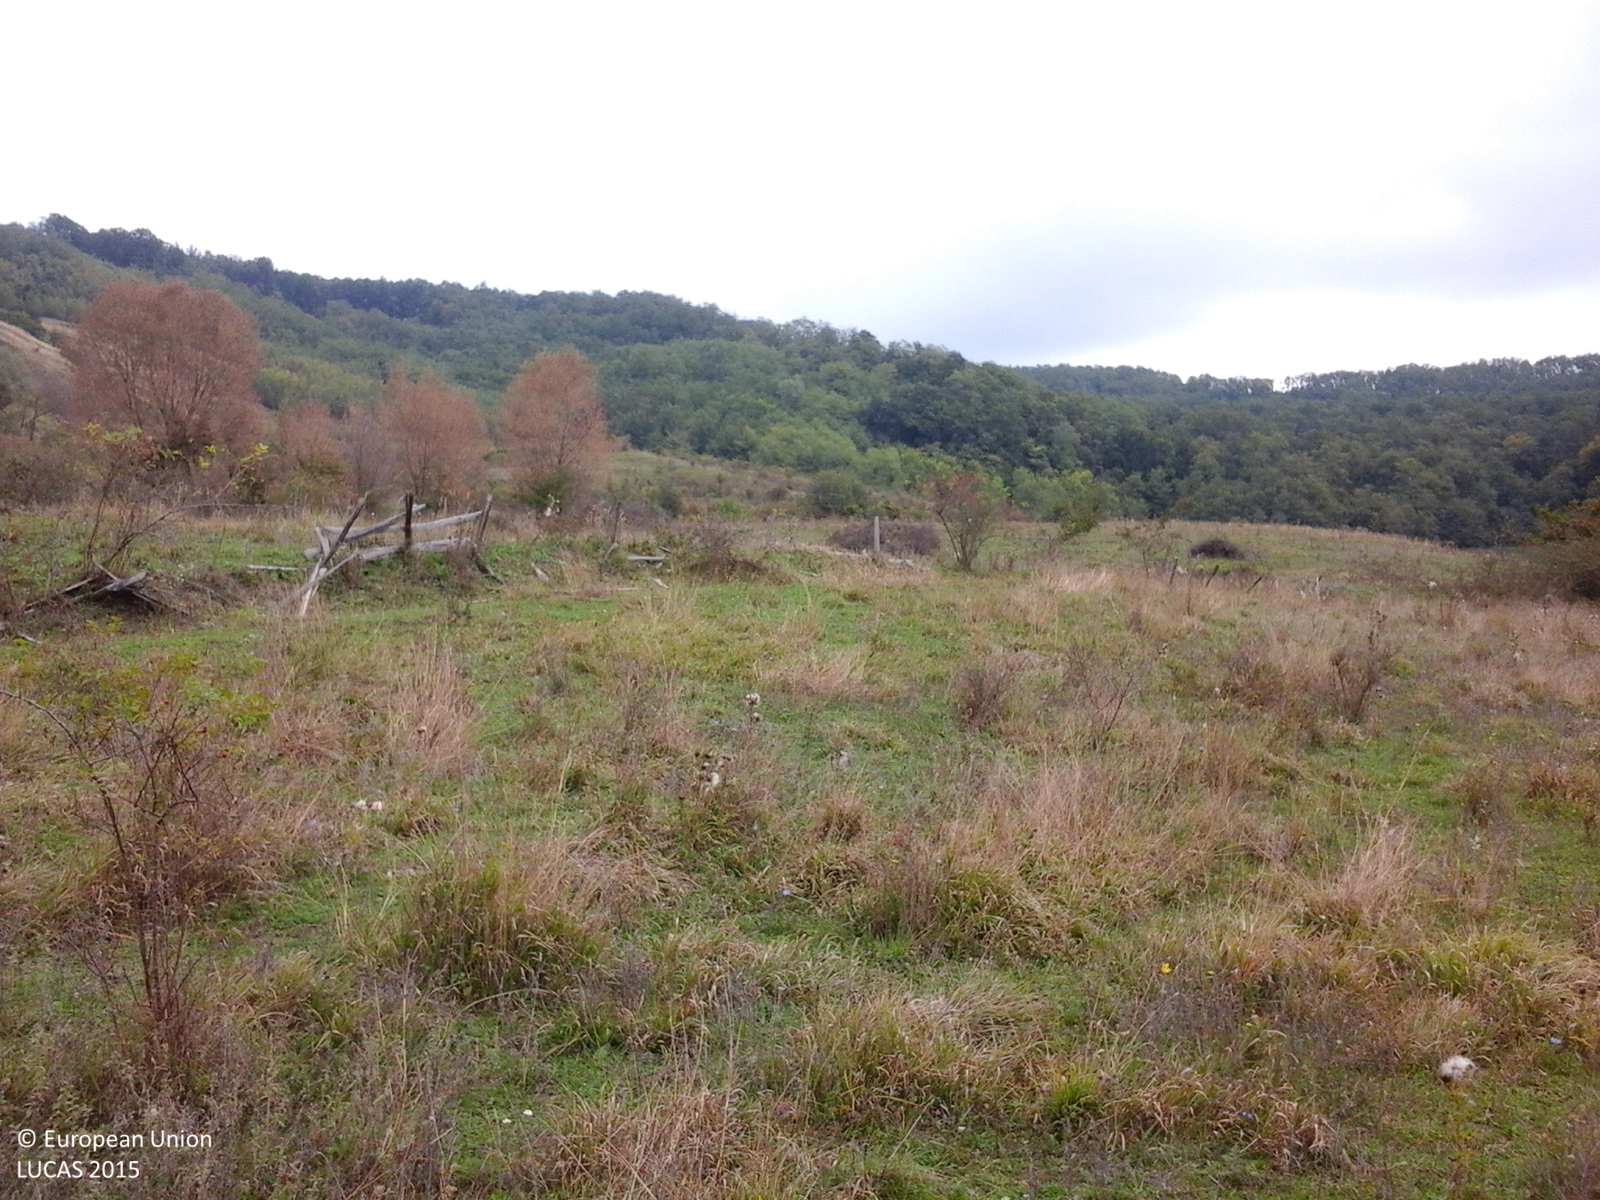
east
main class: Grassland
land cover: Spontaneously vegetated surfaces
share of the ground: > 75 %
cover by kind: herbaceous plants 100 %
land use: Agriculture (excluding fallow land and kitchen gardens)
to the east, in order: Spontaneously vegetated surfaces; Grassland with sparse tree/shrub cover; Tracks; Grassland with sparse tree/shrub cover; Shrubland with sparse tree cover
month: October
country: RO
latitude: 46.1469
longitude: 24.2033
